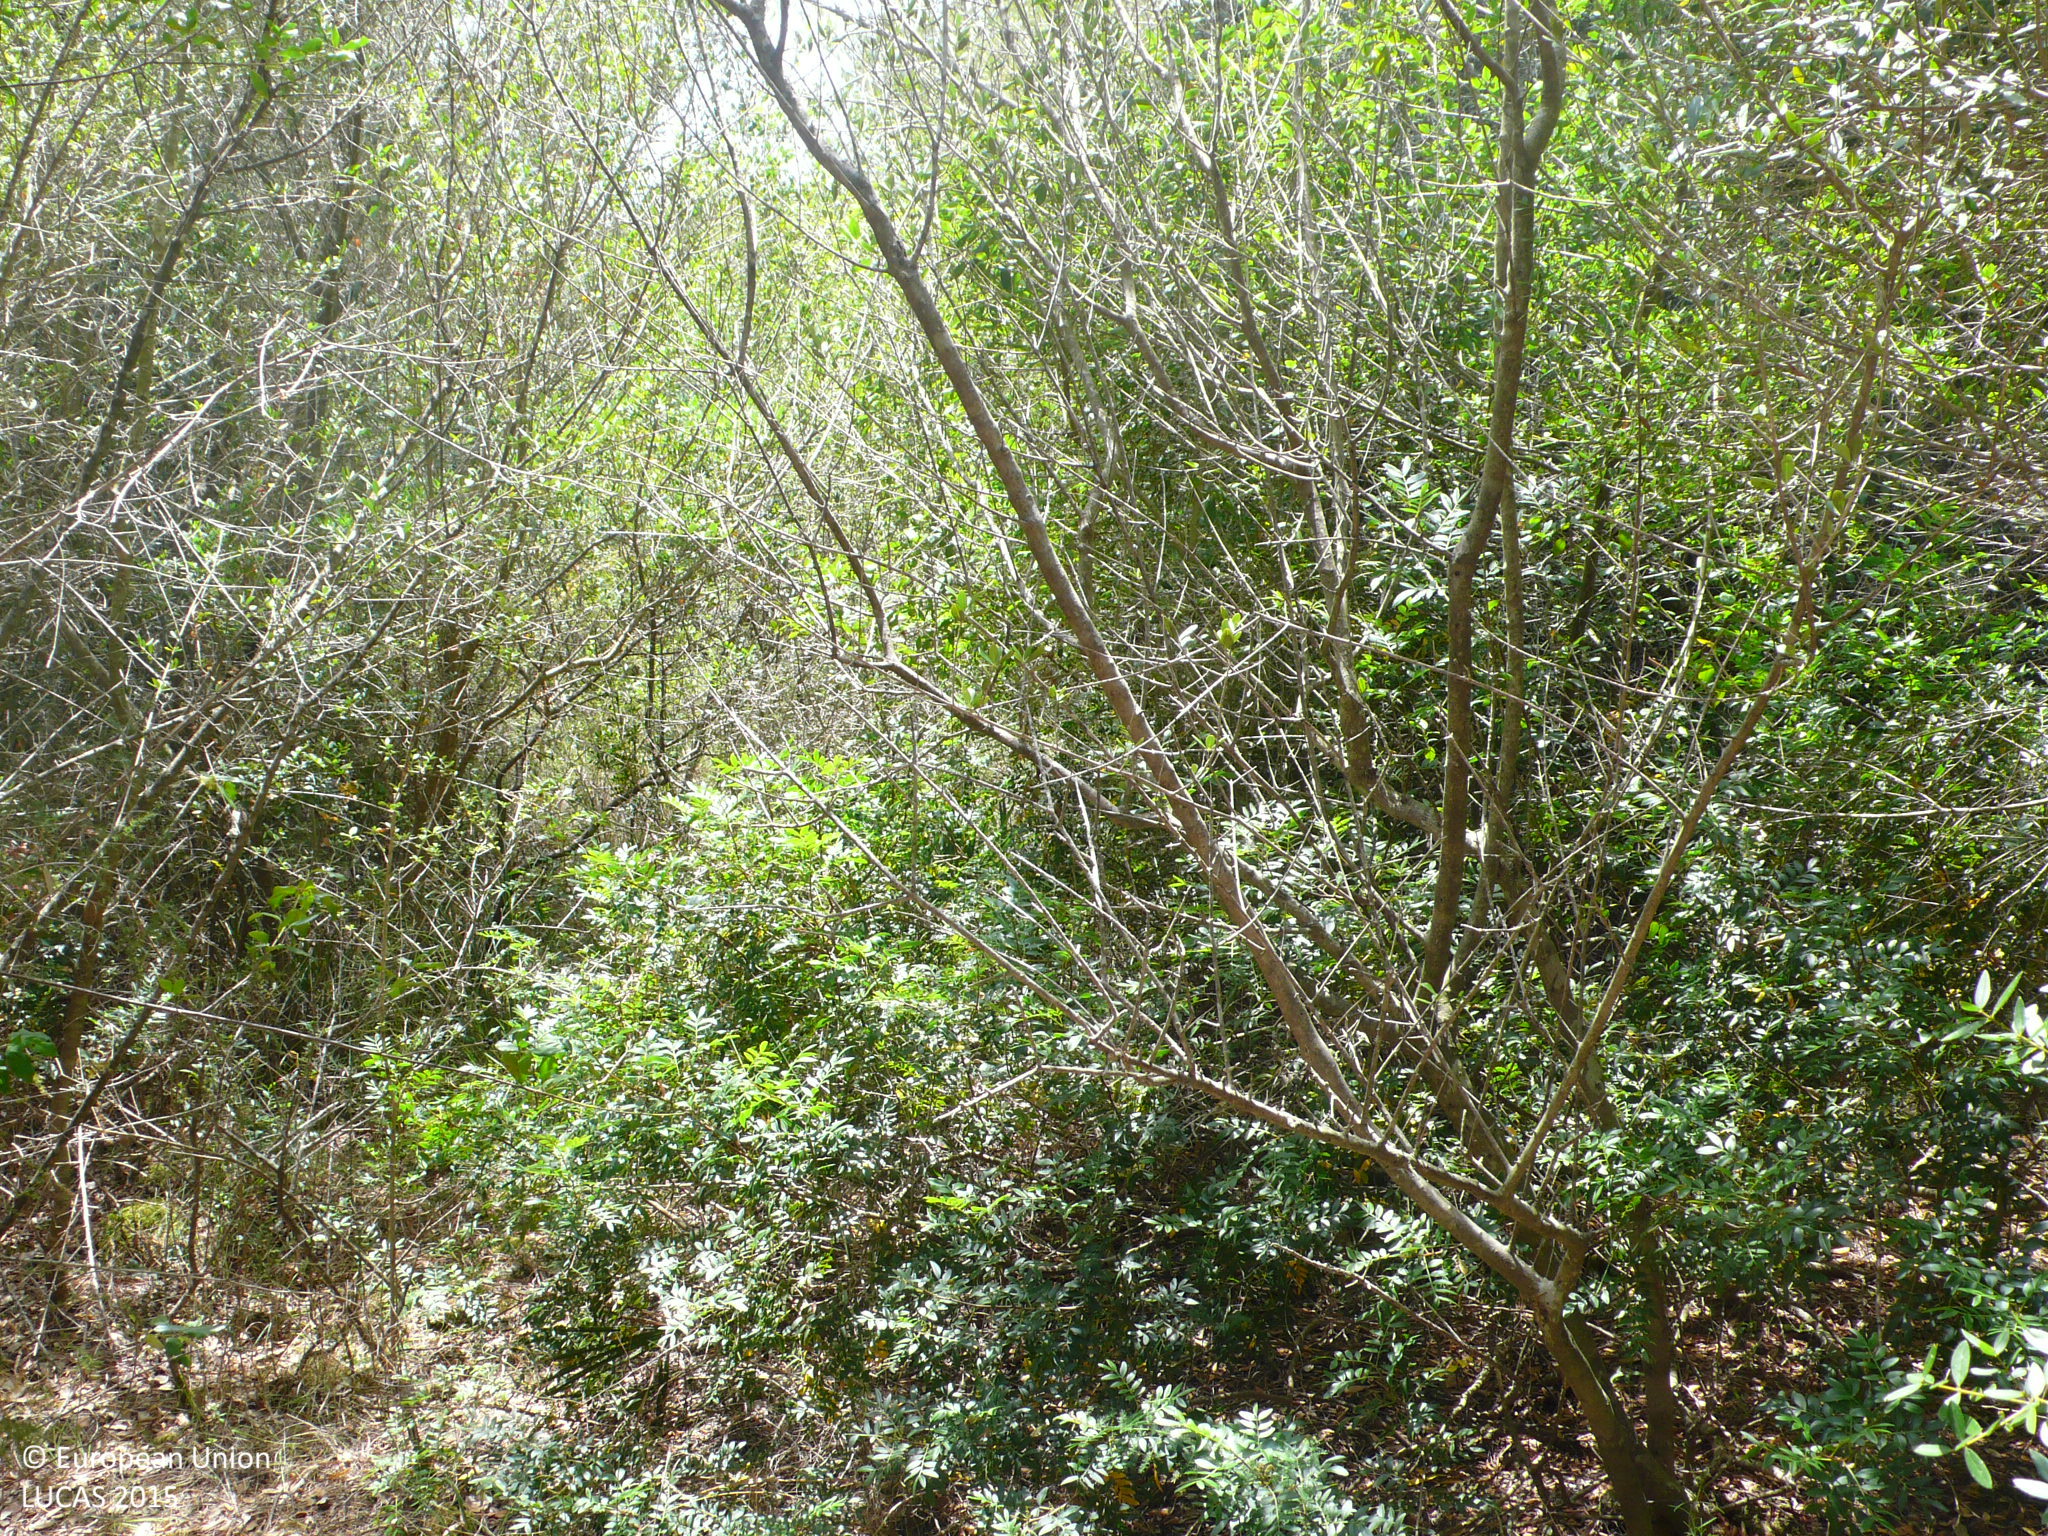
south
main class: Woodland
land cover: Pine dominated mixed woodland
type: coniferous forest of the mediterranean region
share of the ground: > 75 %
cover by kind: coniferous forest trees 55 %, broadleaved forest trees 35 %, shrubs 10 %
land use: Semi-natural and natural areas not in use
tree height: > 5 m
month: July
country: ES
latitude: 39.6586
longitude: 3.3273
